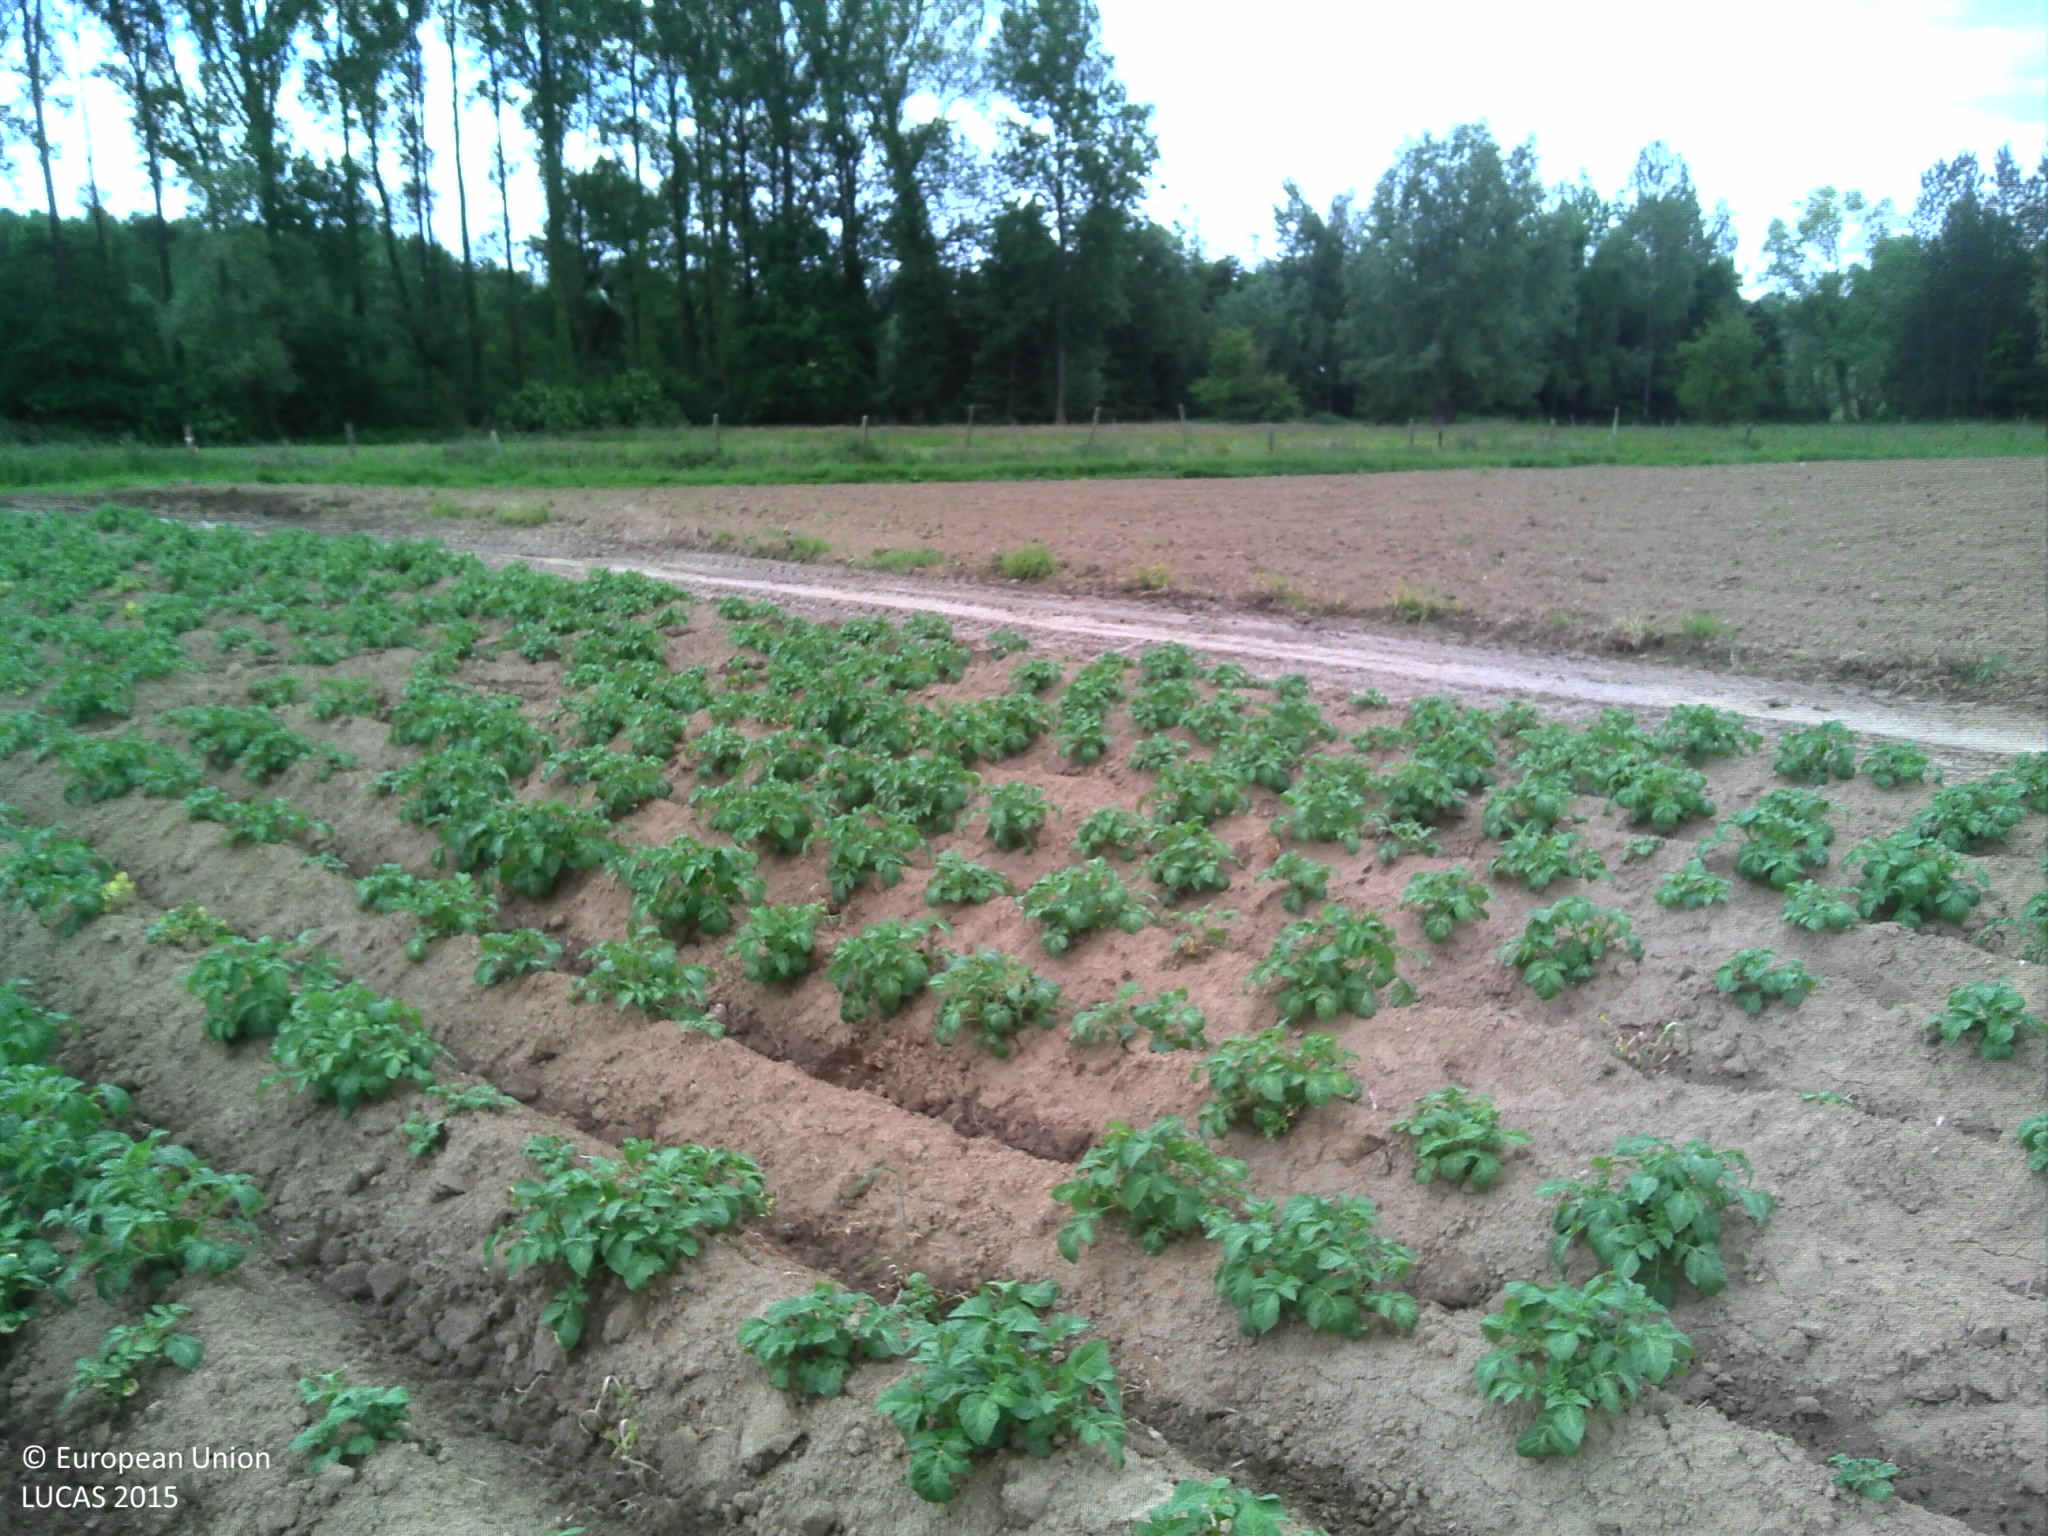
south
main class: Cropland
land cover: Potatoes
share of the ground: 50 - 75 %
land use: Agriculture (excluding fallow land and kitchen gardens)
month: June
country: BE
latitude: 50.8877
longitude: 3.9239
